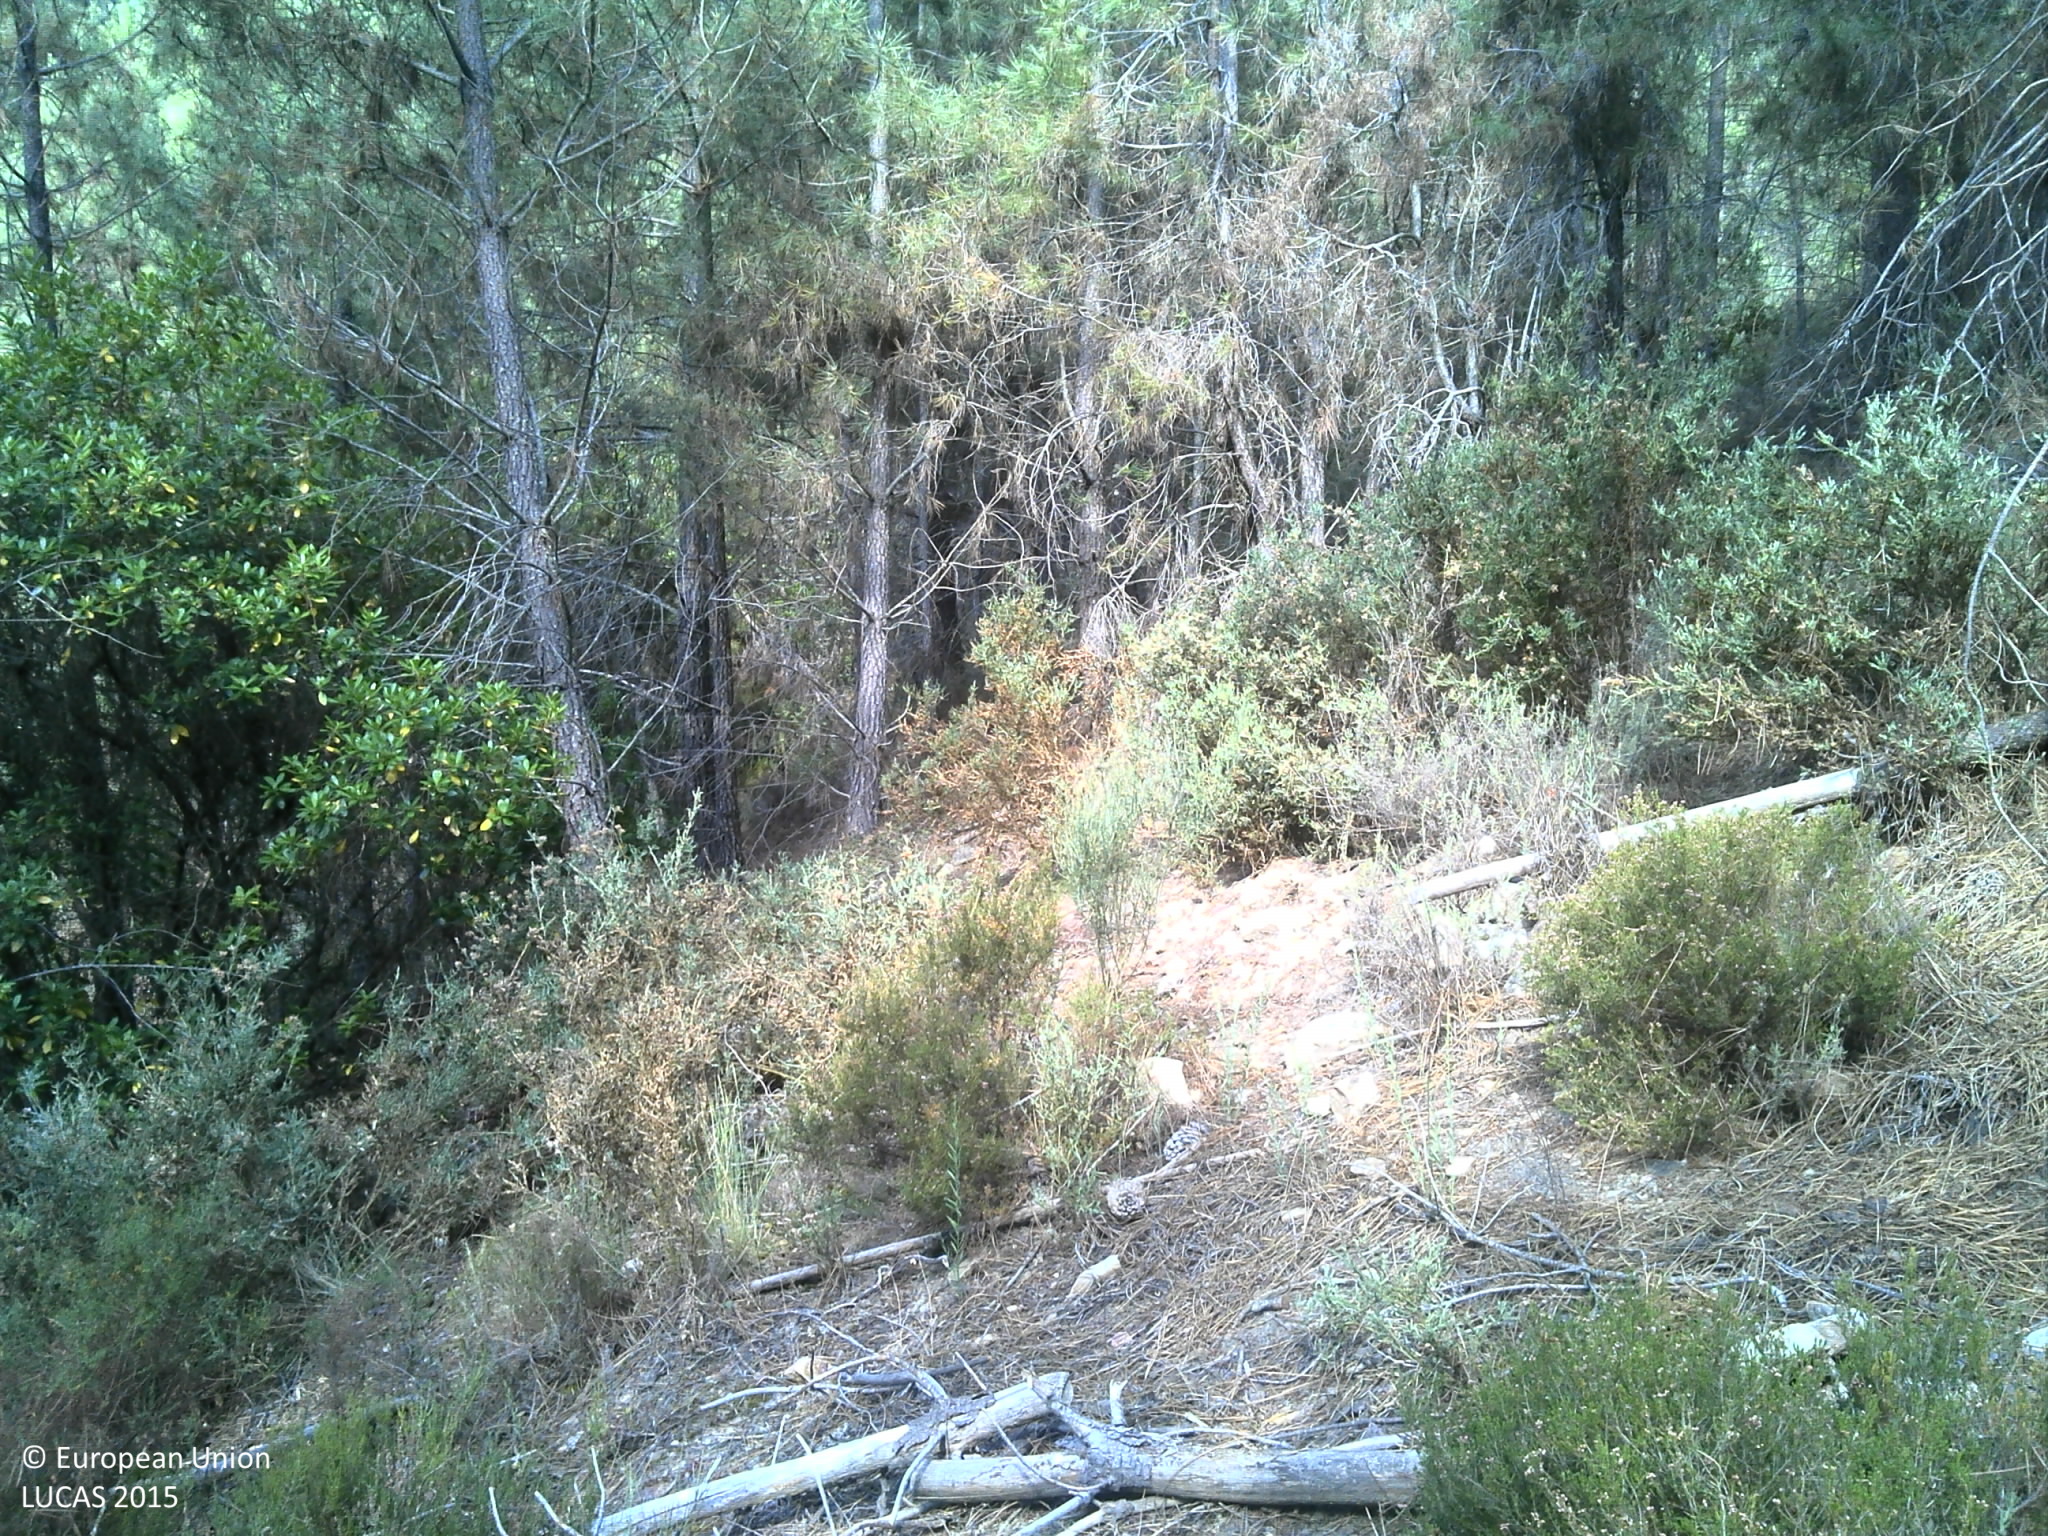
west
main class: Woodland
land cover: Pine dominated coniferous woodland
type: coniferous forest of the mediterranean region
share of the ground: 50 - 75 %
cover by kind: coniferous forest trees 60 %, unconsolidated bare surface 25 %, shrubs 15 %
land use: Forestry
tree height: > 5 m
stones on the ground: 10 - 25 %
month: June
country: PT
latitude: 41.2614
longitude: -7.5143
